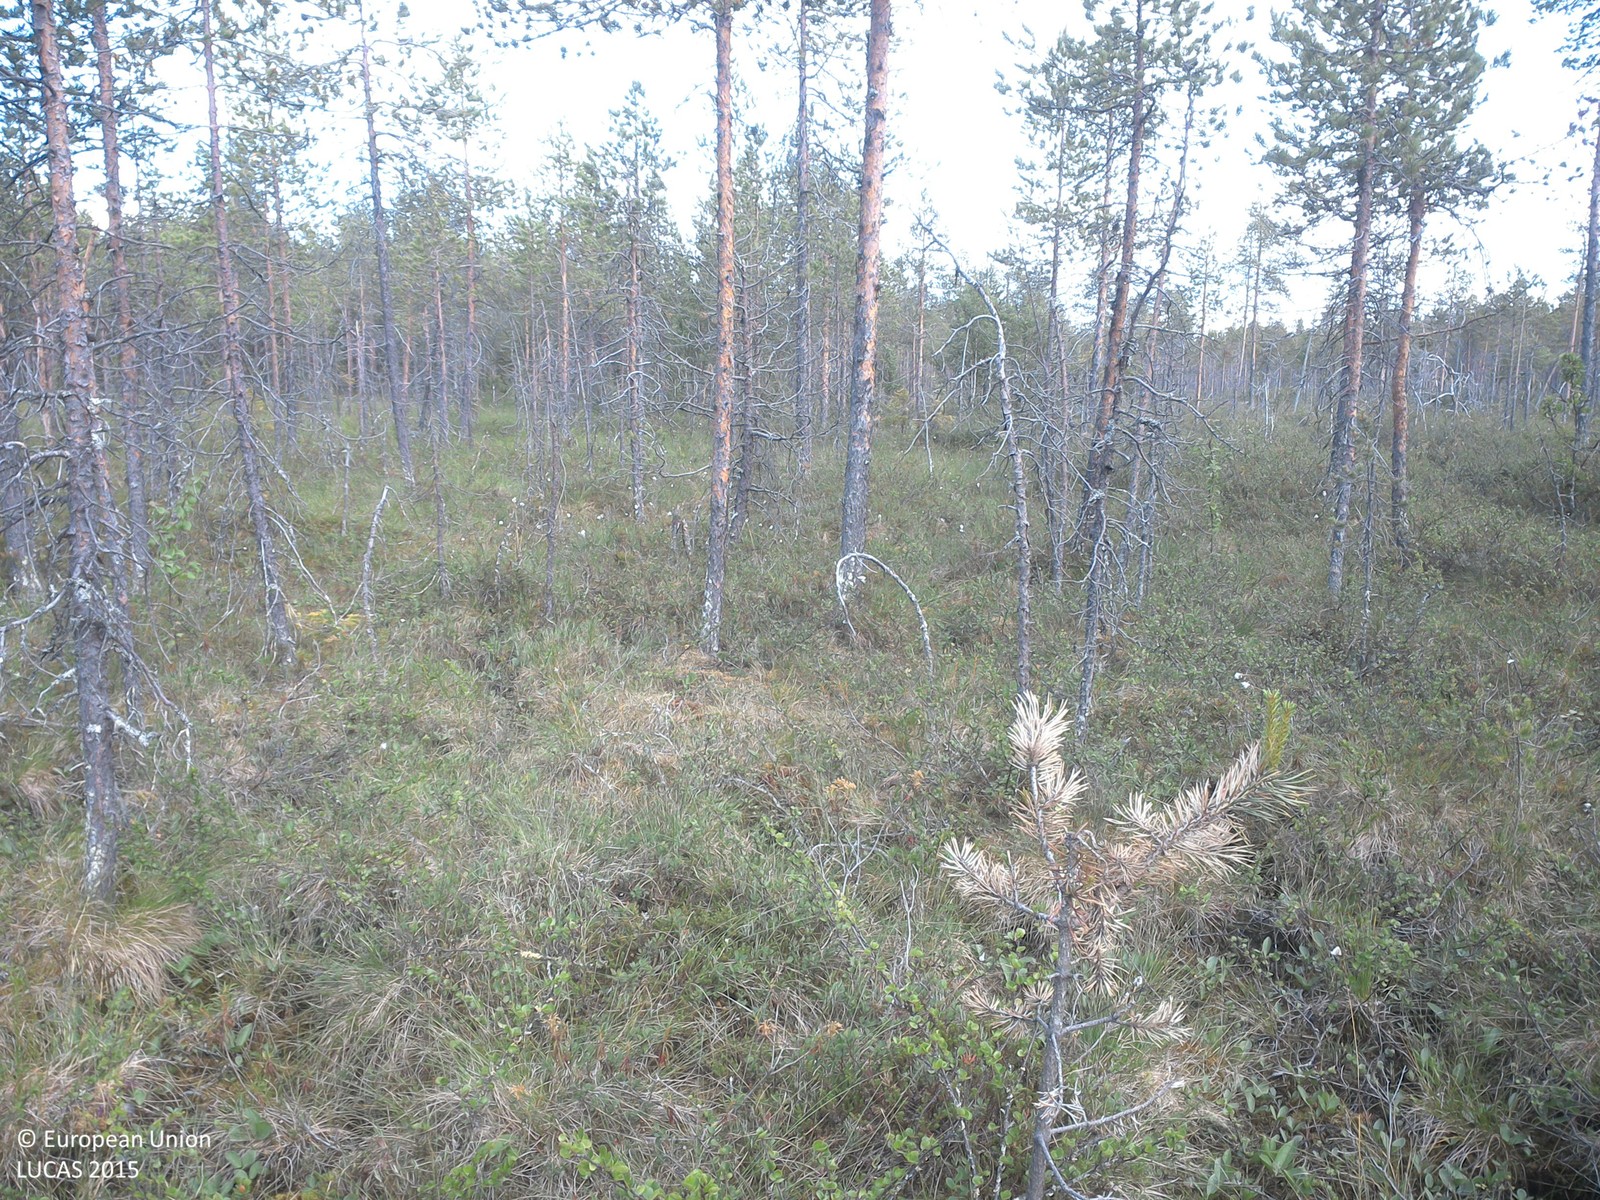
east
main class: Woodland
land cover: Pine dominated coniferous woodland
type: boreal forest
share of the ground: 10 - 25 %
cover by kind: shrubs 65 %, coniferous forest trees 15 %, lichens and mosses 15 %, herbaceous plants 5 %
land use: Forestry
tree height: < 5 m
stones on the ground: < 10 %
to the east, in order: Pine dominated coniferous woodland; Ditches and canals; Pine dominated mixed woodland; Pine dominated coniferous woodland
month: July
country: SE
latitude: 67.4476
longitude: 22.2225
